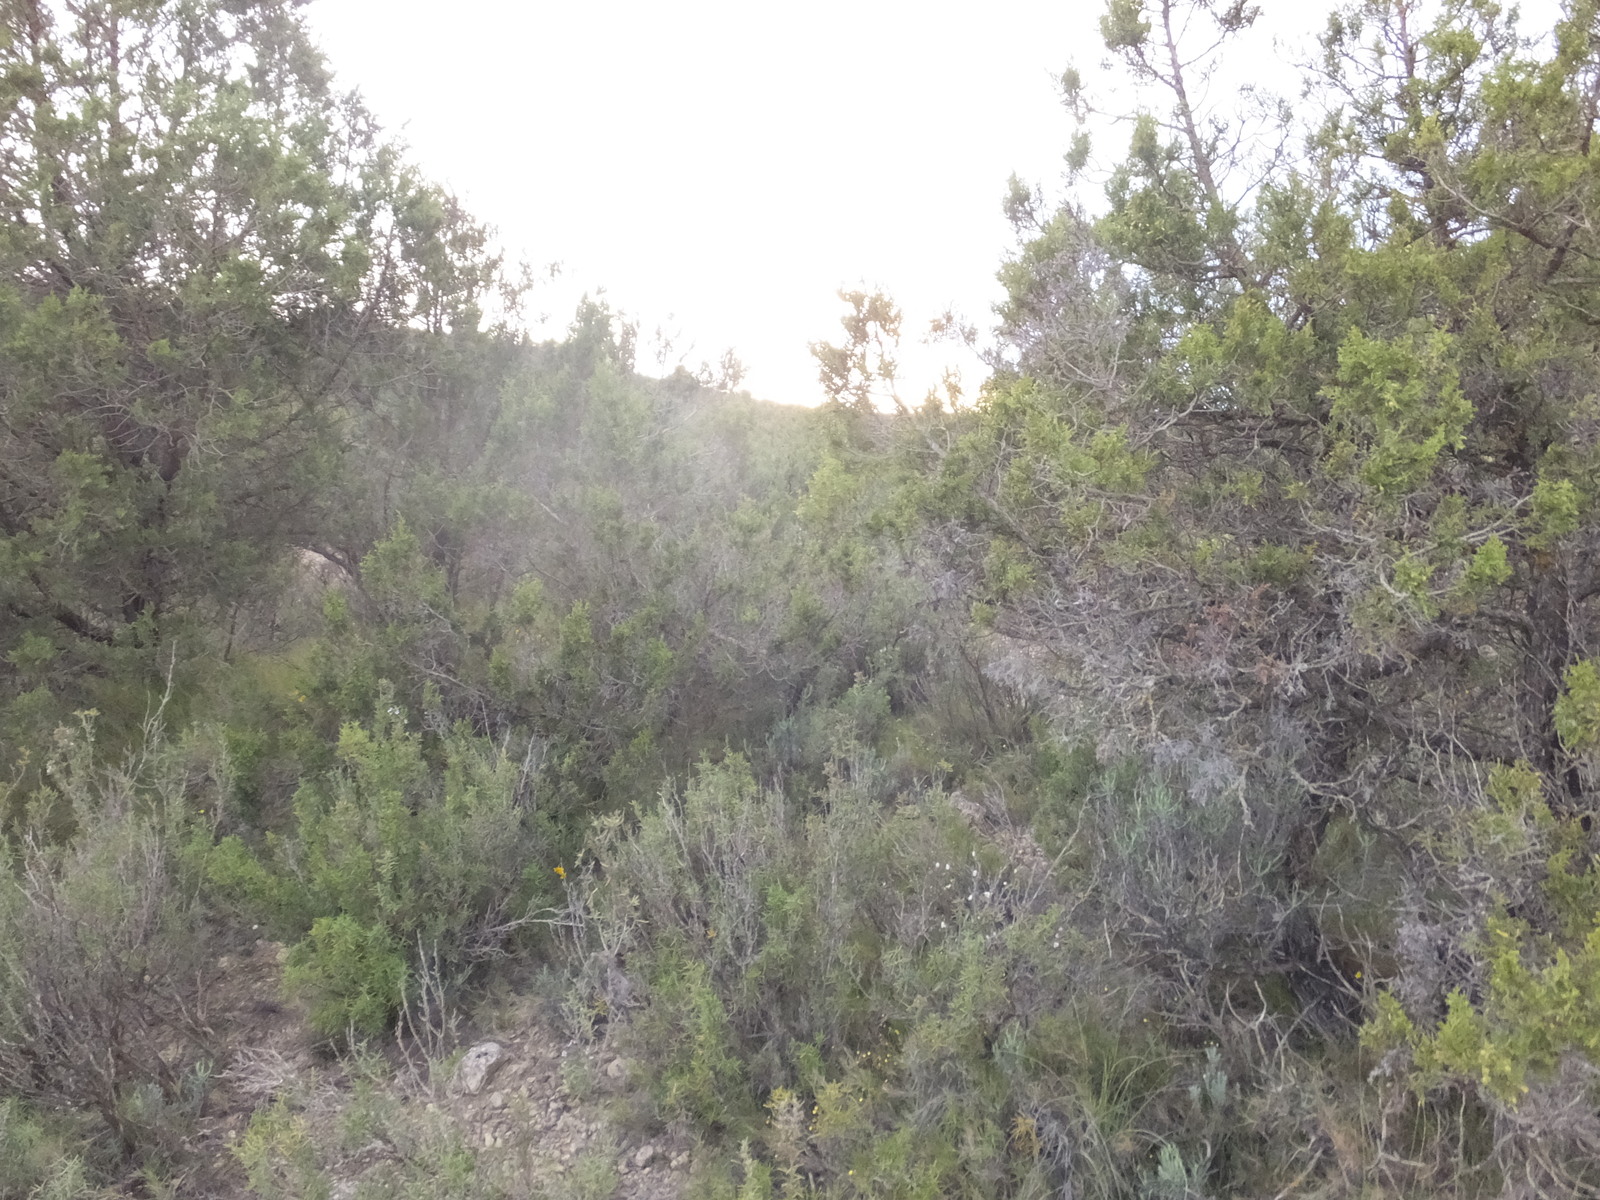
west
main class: Shrubland
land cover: Shrubland with sparse tree cover
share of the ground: > 75 %
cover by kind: shrubs 75 %, herbaceous plants 20 %, coniferous forest trees 5 %
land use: Semi-natural and natural areas not in use
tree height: > 5 m
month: April
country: ES
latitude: 41.6715
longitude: -0.3115
